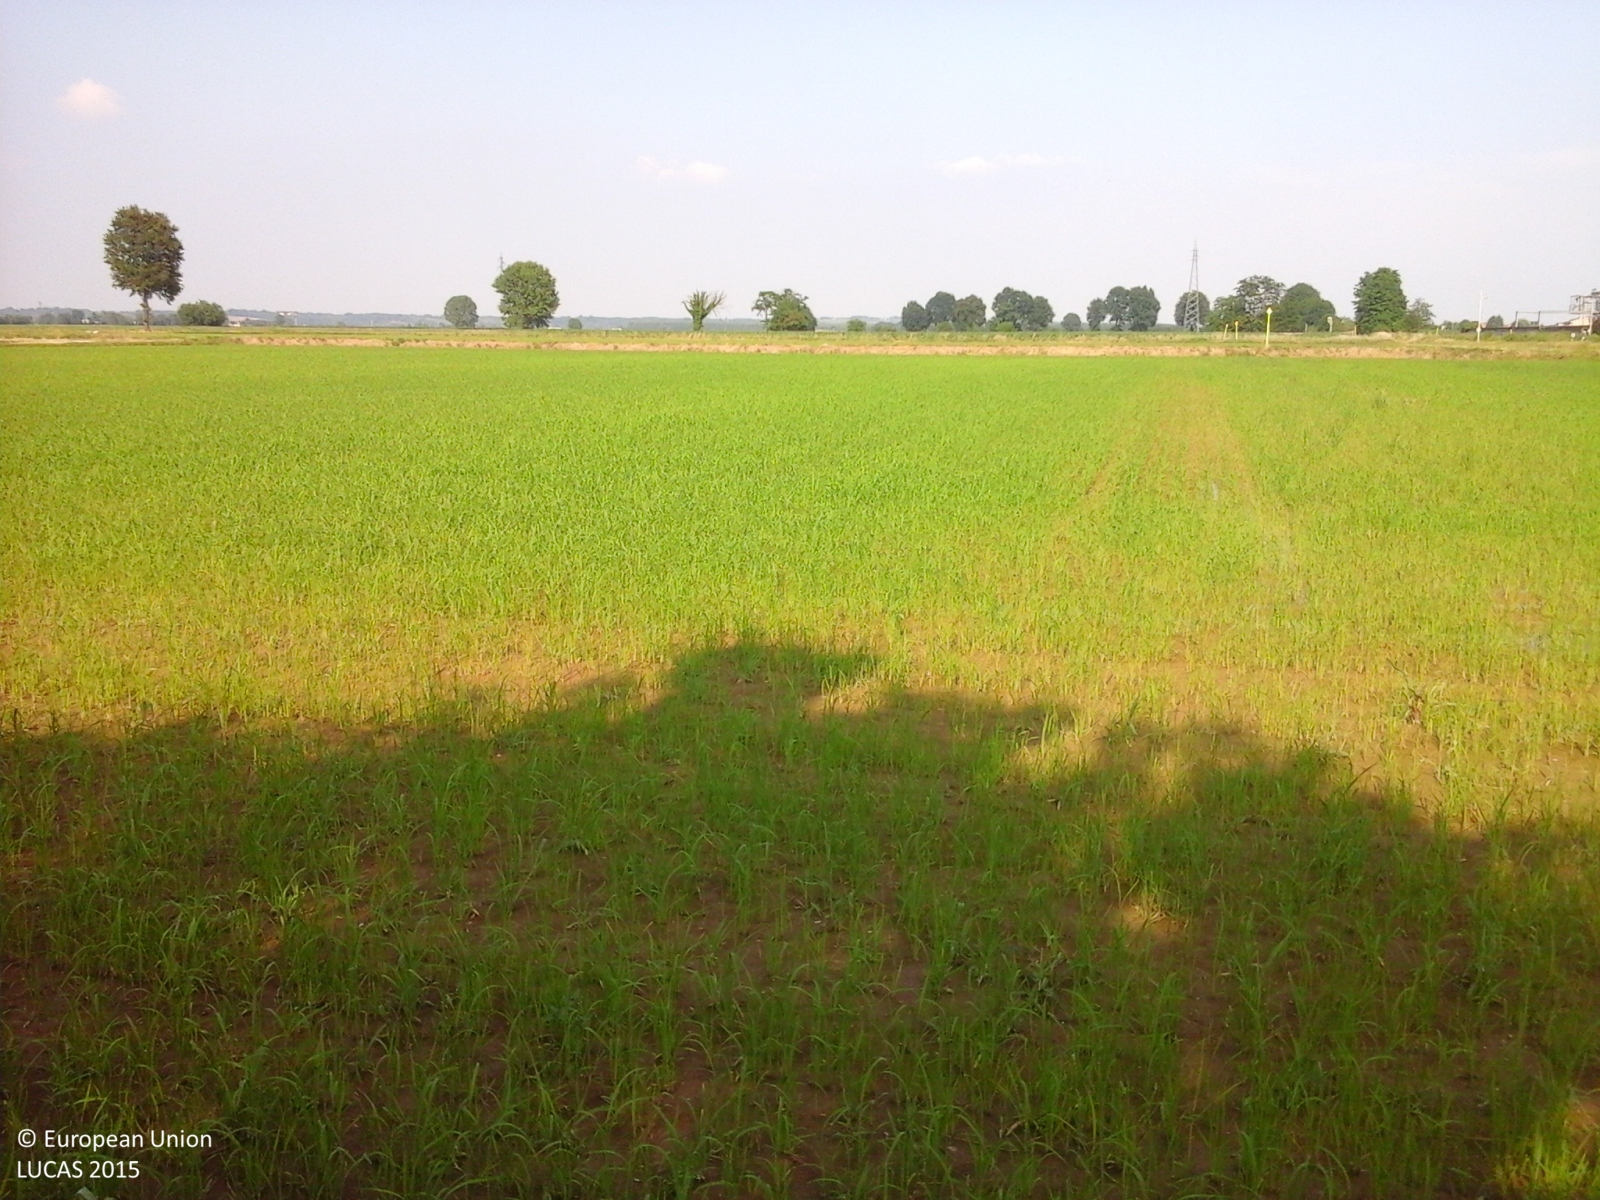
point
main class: Cropland
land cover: Rice
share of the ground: > 75 %
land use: Agriculture (excluding fallow land and kitchen gardens)
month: June
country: IT
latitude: 45.1601
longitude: 9.3778
